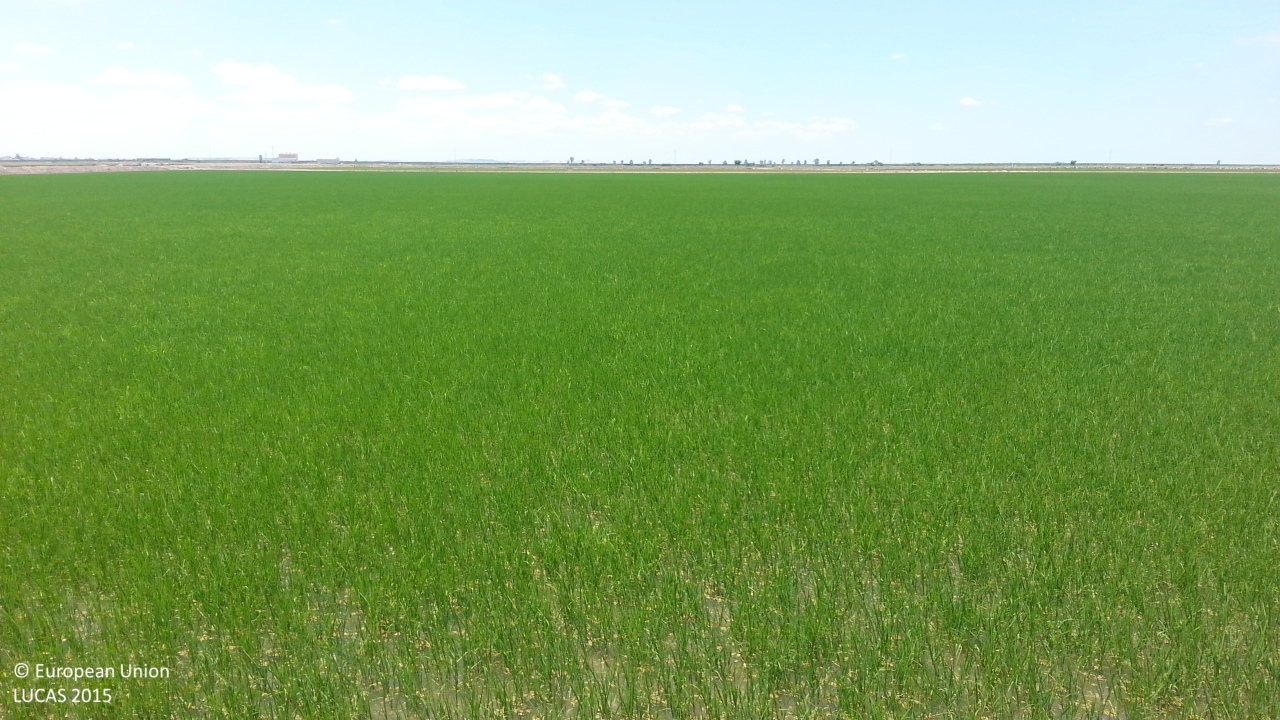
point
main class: Cropland
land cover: Rice
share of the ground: > 75 %
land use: Agriculture (excluding fallow land and kitchen gardens)
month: June
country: ES
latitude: 37.0480
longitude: -5.9950
